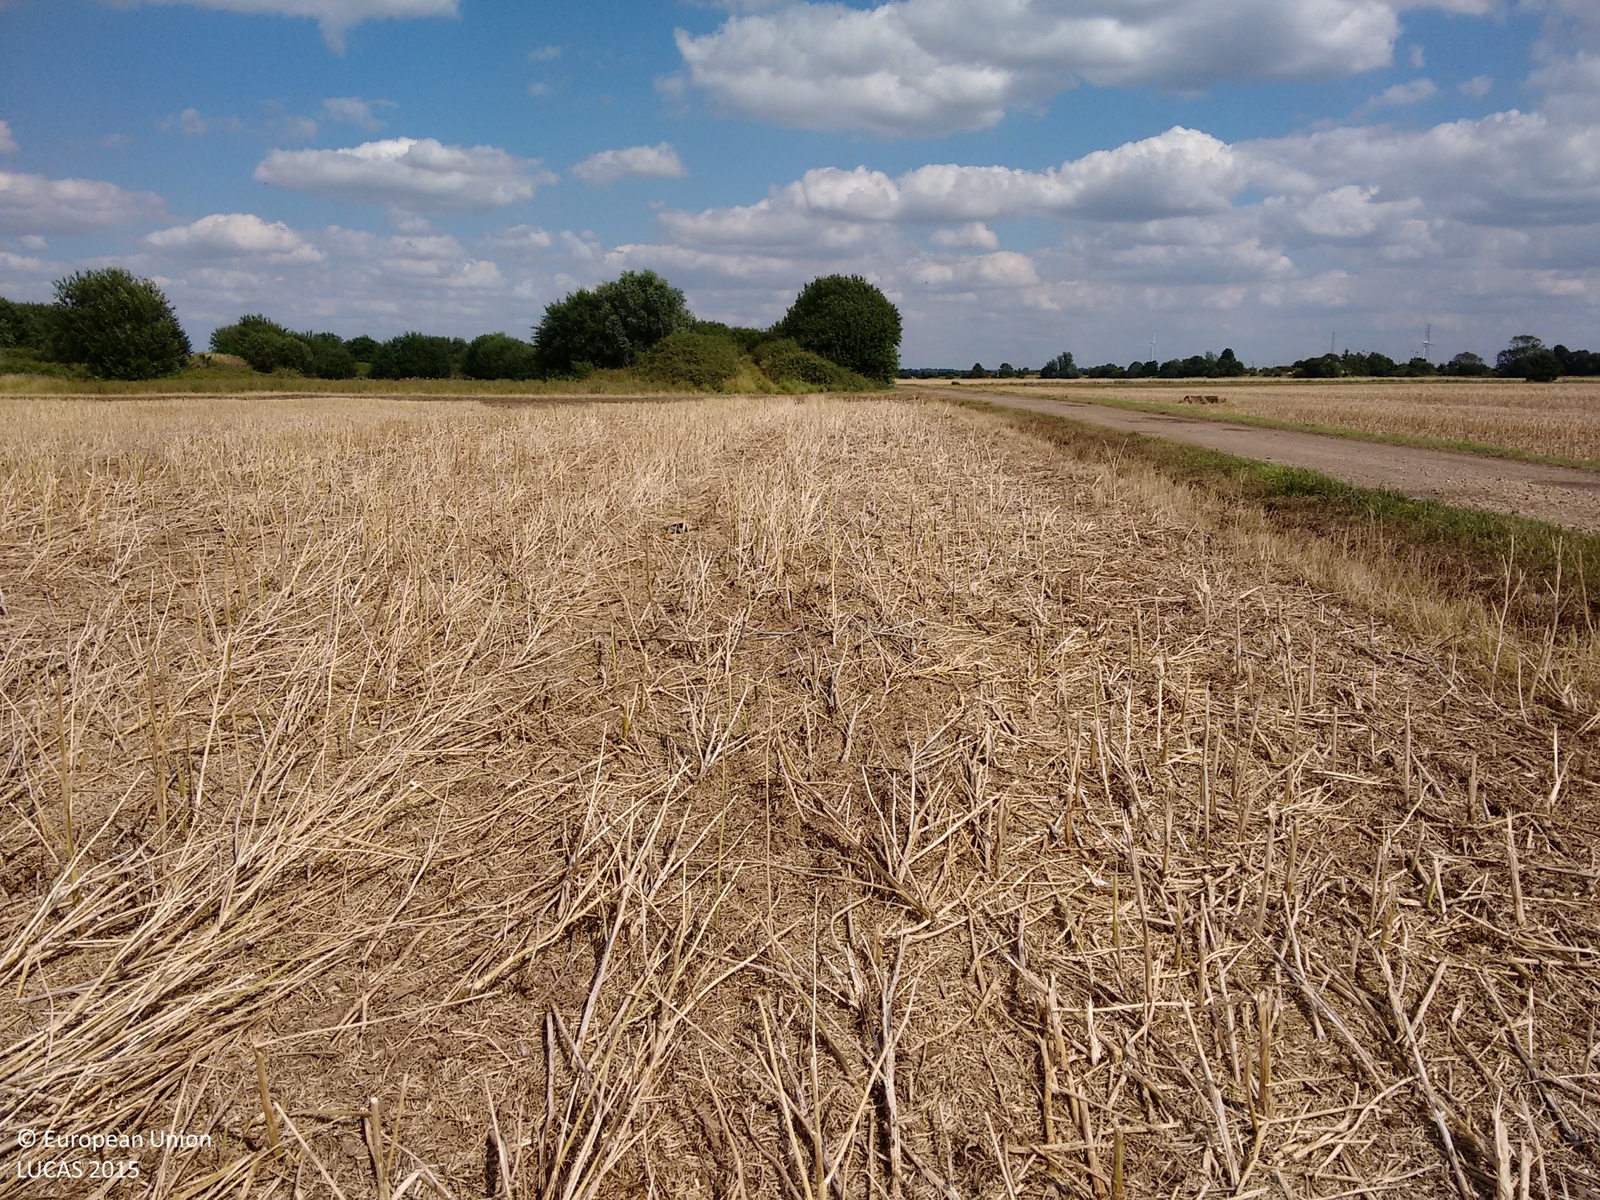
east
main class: Cropland
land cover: Rape and turnip rape
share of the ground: > 75 %
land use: Agriculture (excluding fallow land and kitchen gardens)
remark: Harvested field
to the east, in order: Rape and turnip rape; Grass margins; Tracks; Grass margins; Tracks; Grass margins; Rape and turnip rape
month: July
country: GB
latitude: 52.7803
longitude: 0.3495
